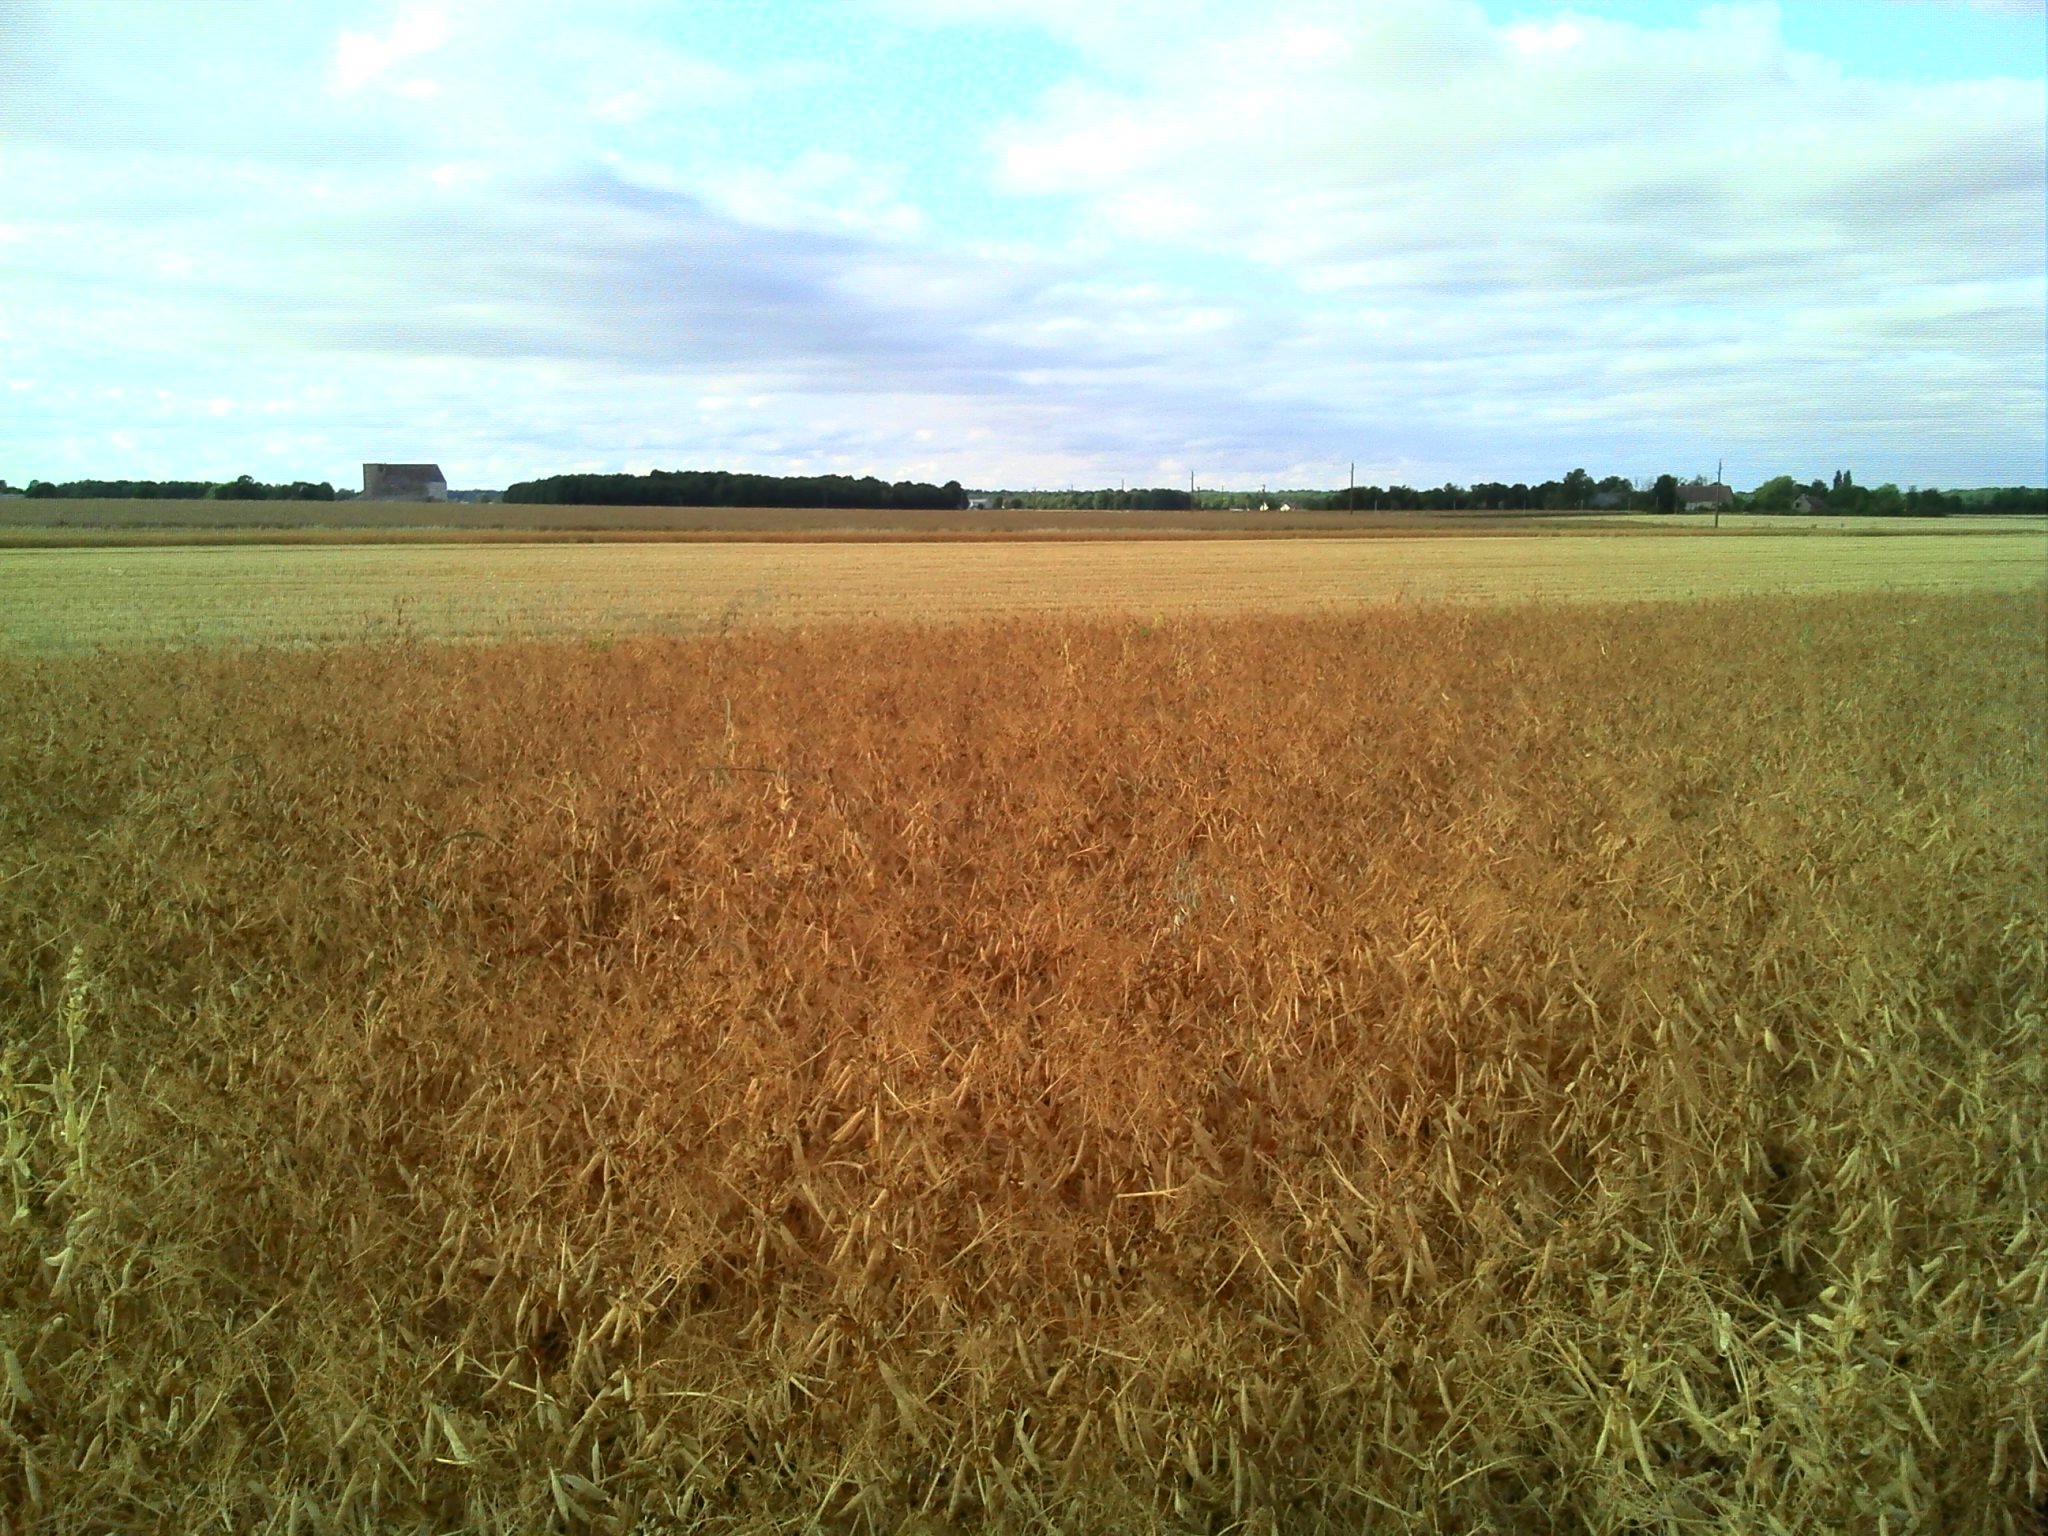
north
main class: Cropland
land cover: Dry pulses
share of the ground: > 75 %
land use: Agriculture (excluding fallow land and kitchen gardens)
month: July
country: FR
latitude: 48.6876
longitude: 0.7808
